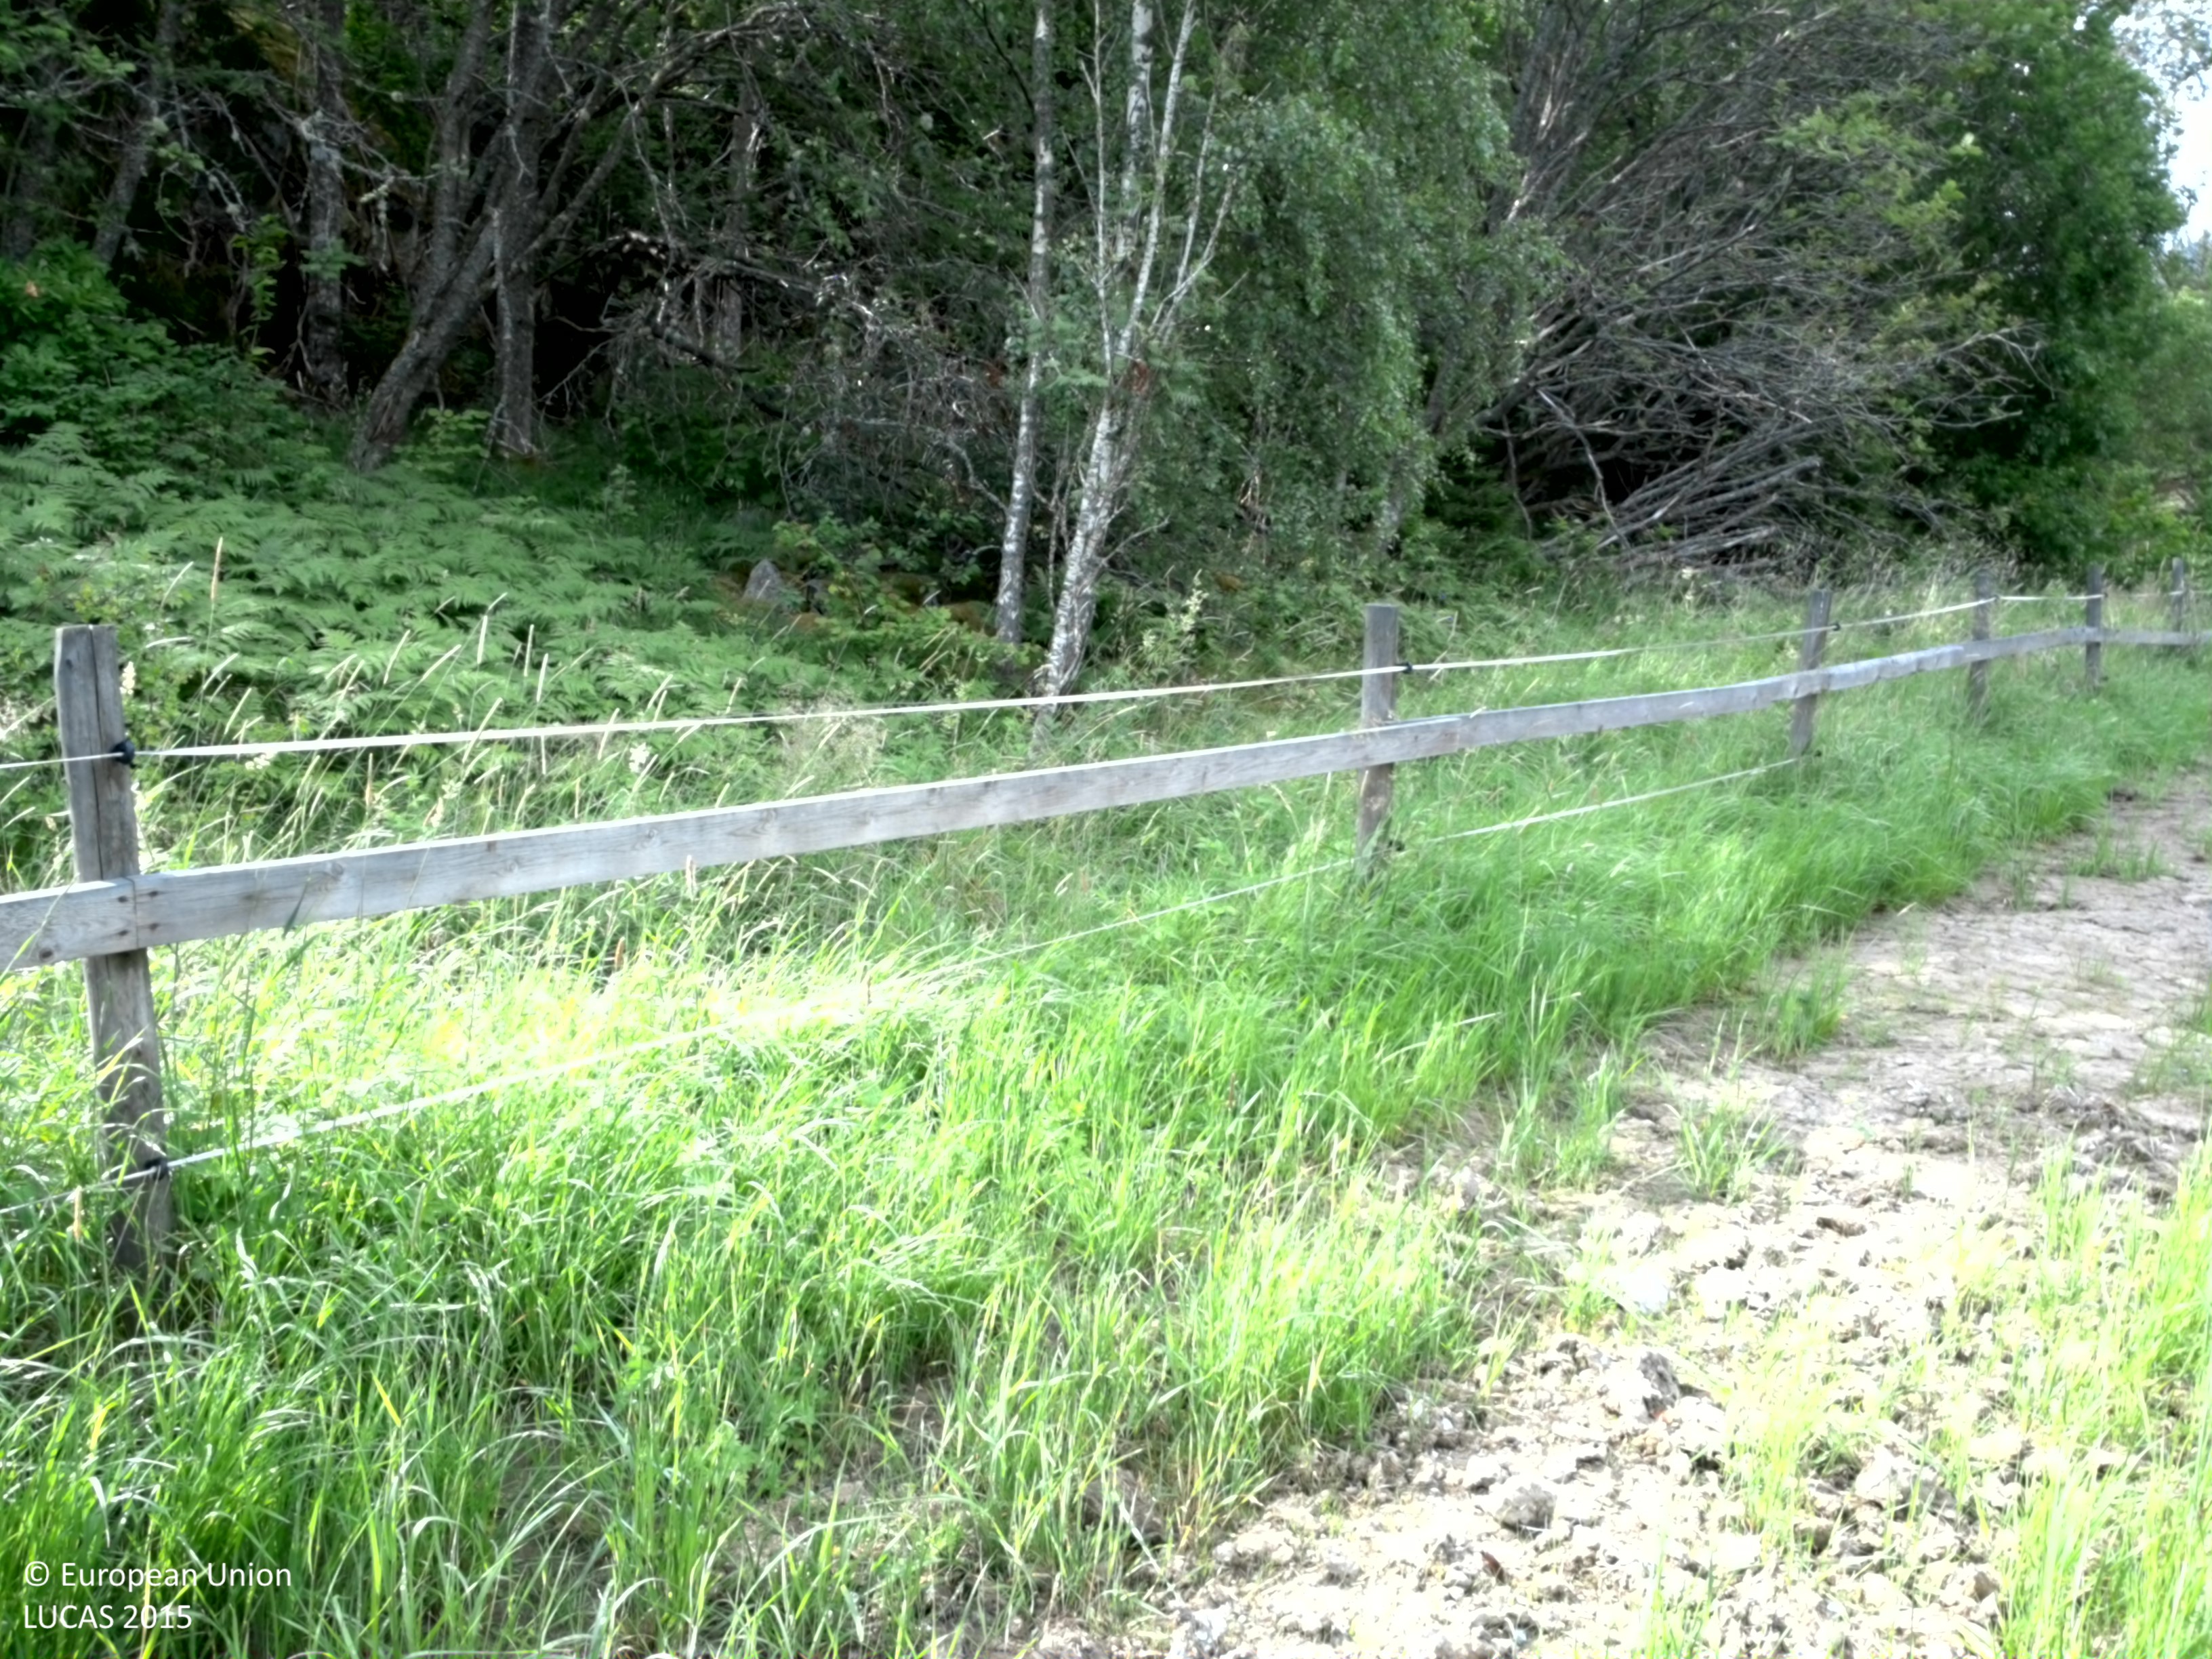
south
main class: Grassland
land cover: Grassland without tree/shrub cover
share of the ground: > 75 %
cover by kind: herbaceous plants 90 %, unconsolidated bare surface 10 %
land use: Agriculture (excluding fallow land and kitchen gardens)
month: July
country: SE
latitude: 59.7684
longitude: 18.6712
